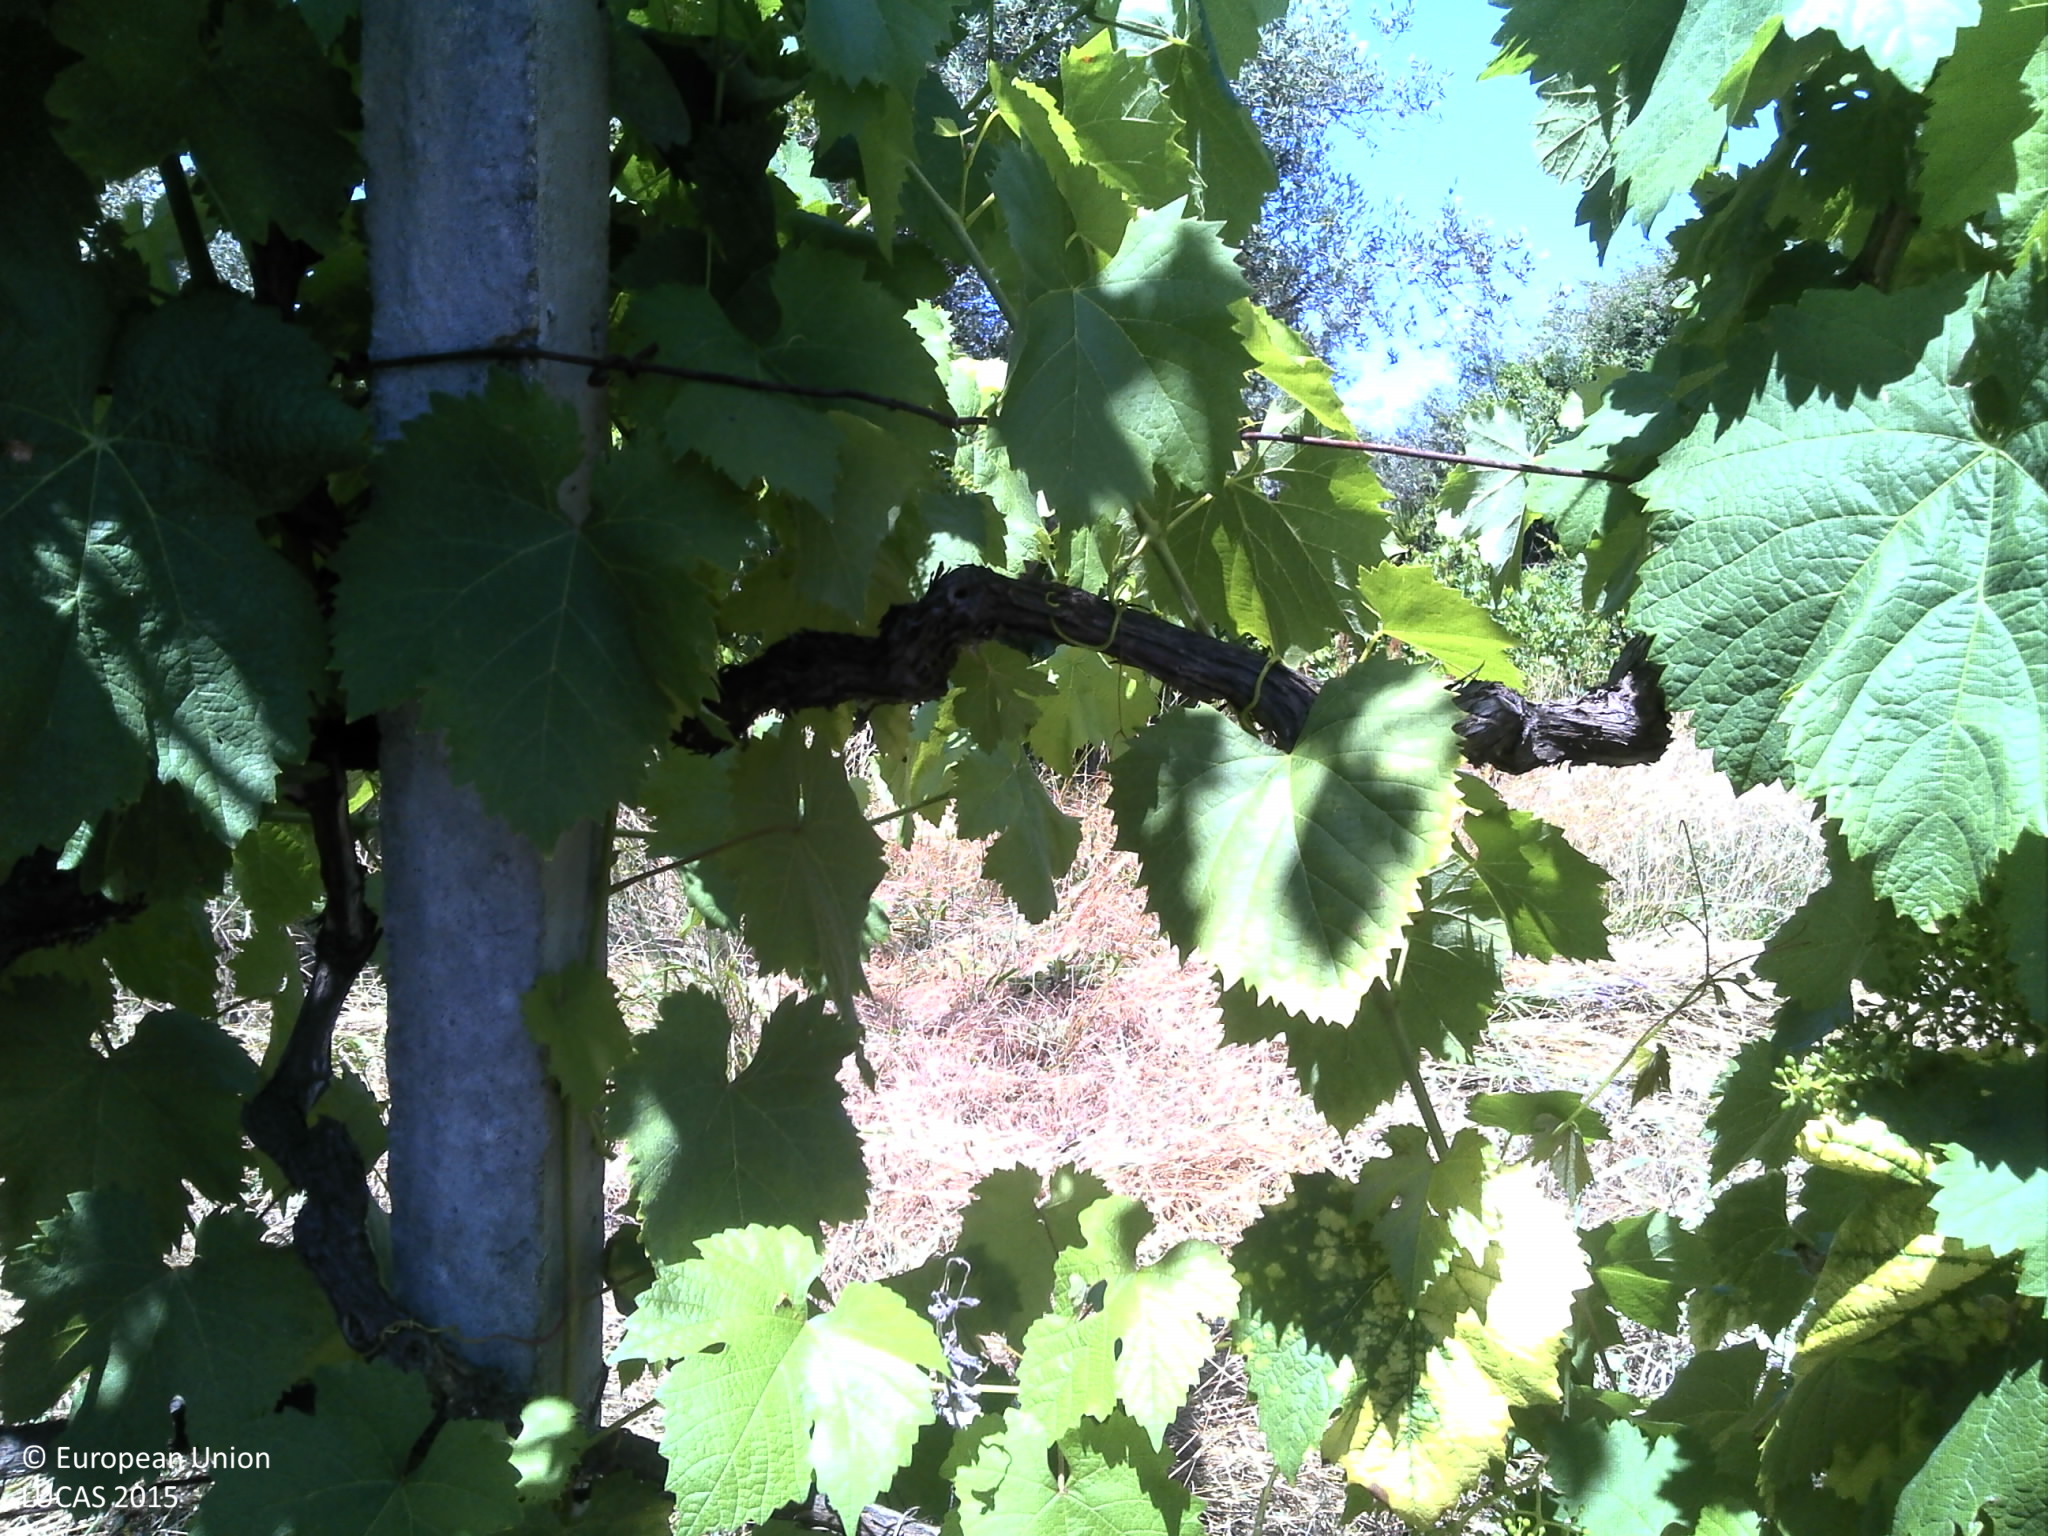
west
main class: Cropland
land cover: Vineyards
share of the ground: < 10 %
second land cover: Grassland without tree/shrub cover
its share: 10 - 25 %
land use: Agriculture (excluding fallow land and kitchen gardens)
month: June
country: PT
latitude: 40.7794
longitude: -8.0337
